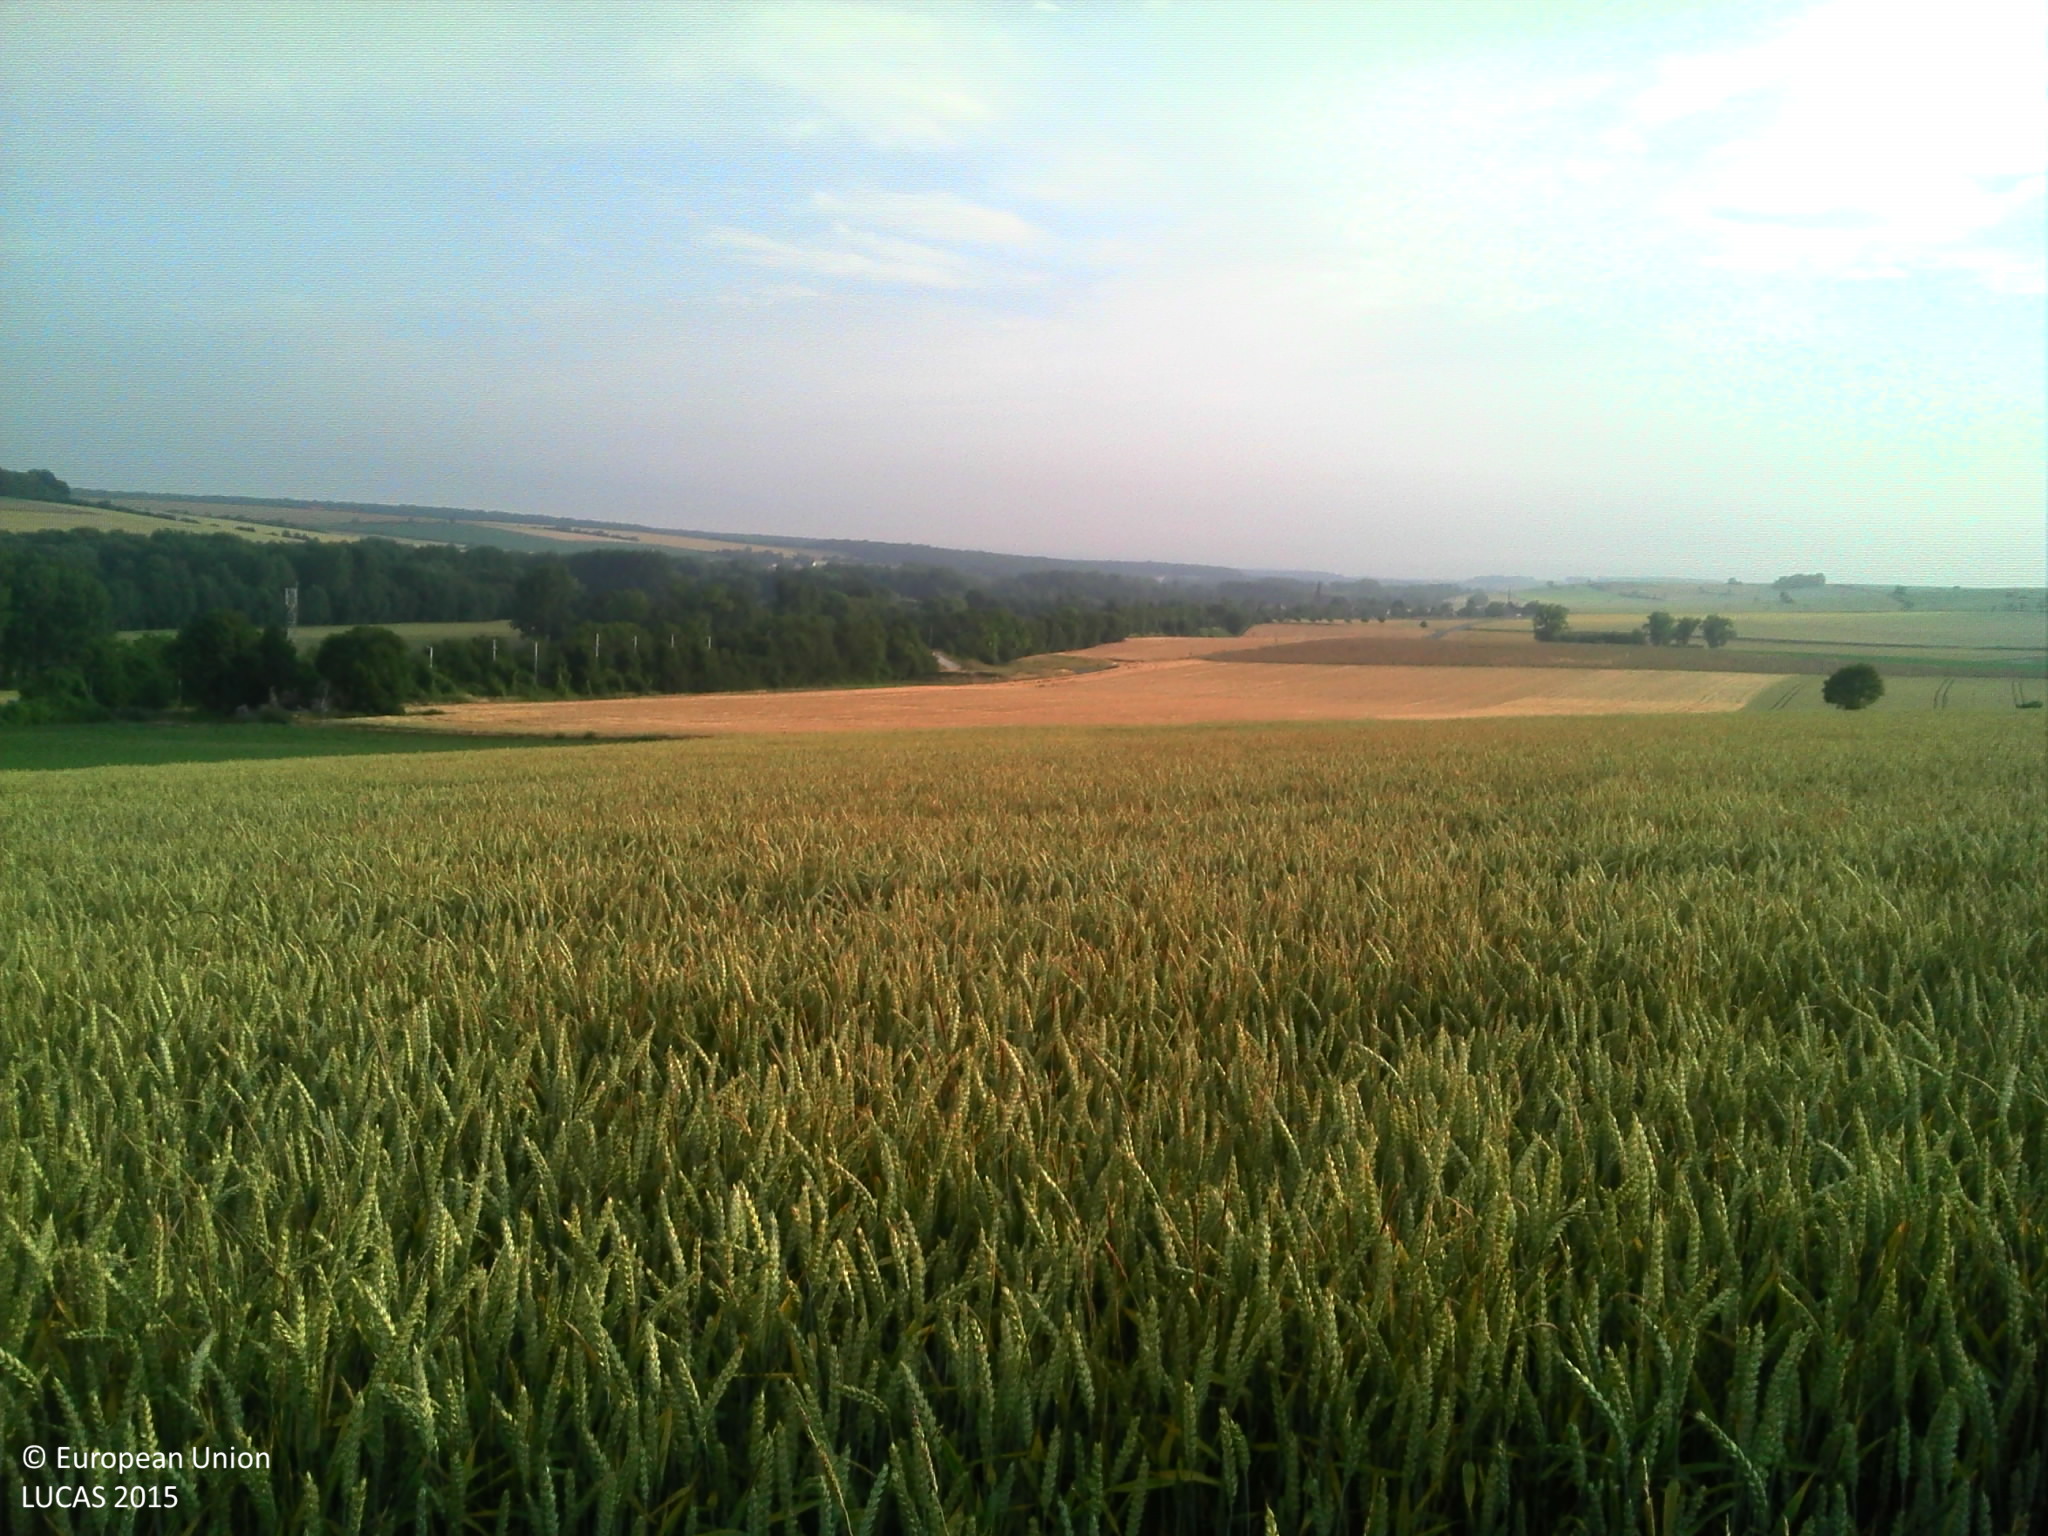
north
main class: Cropland
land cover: Common wheat
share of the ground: > 75 %
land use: Agriculture (excluding fallow land and kitchen gardens)
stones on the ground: 10 - 25 %
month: July
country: FR
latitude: 49.7852
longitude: 2.3898
